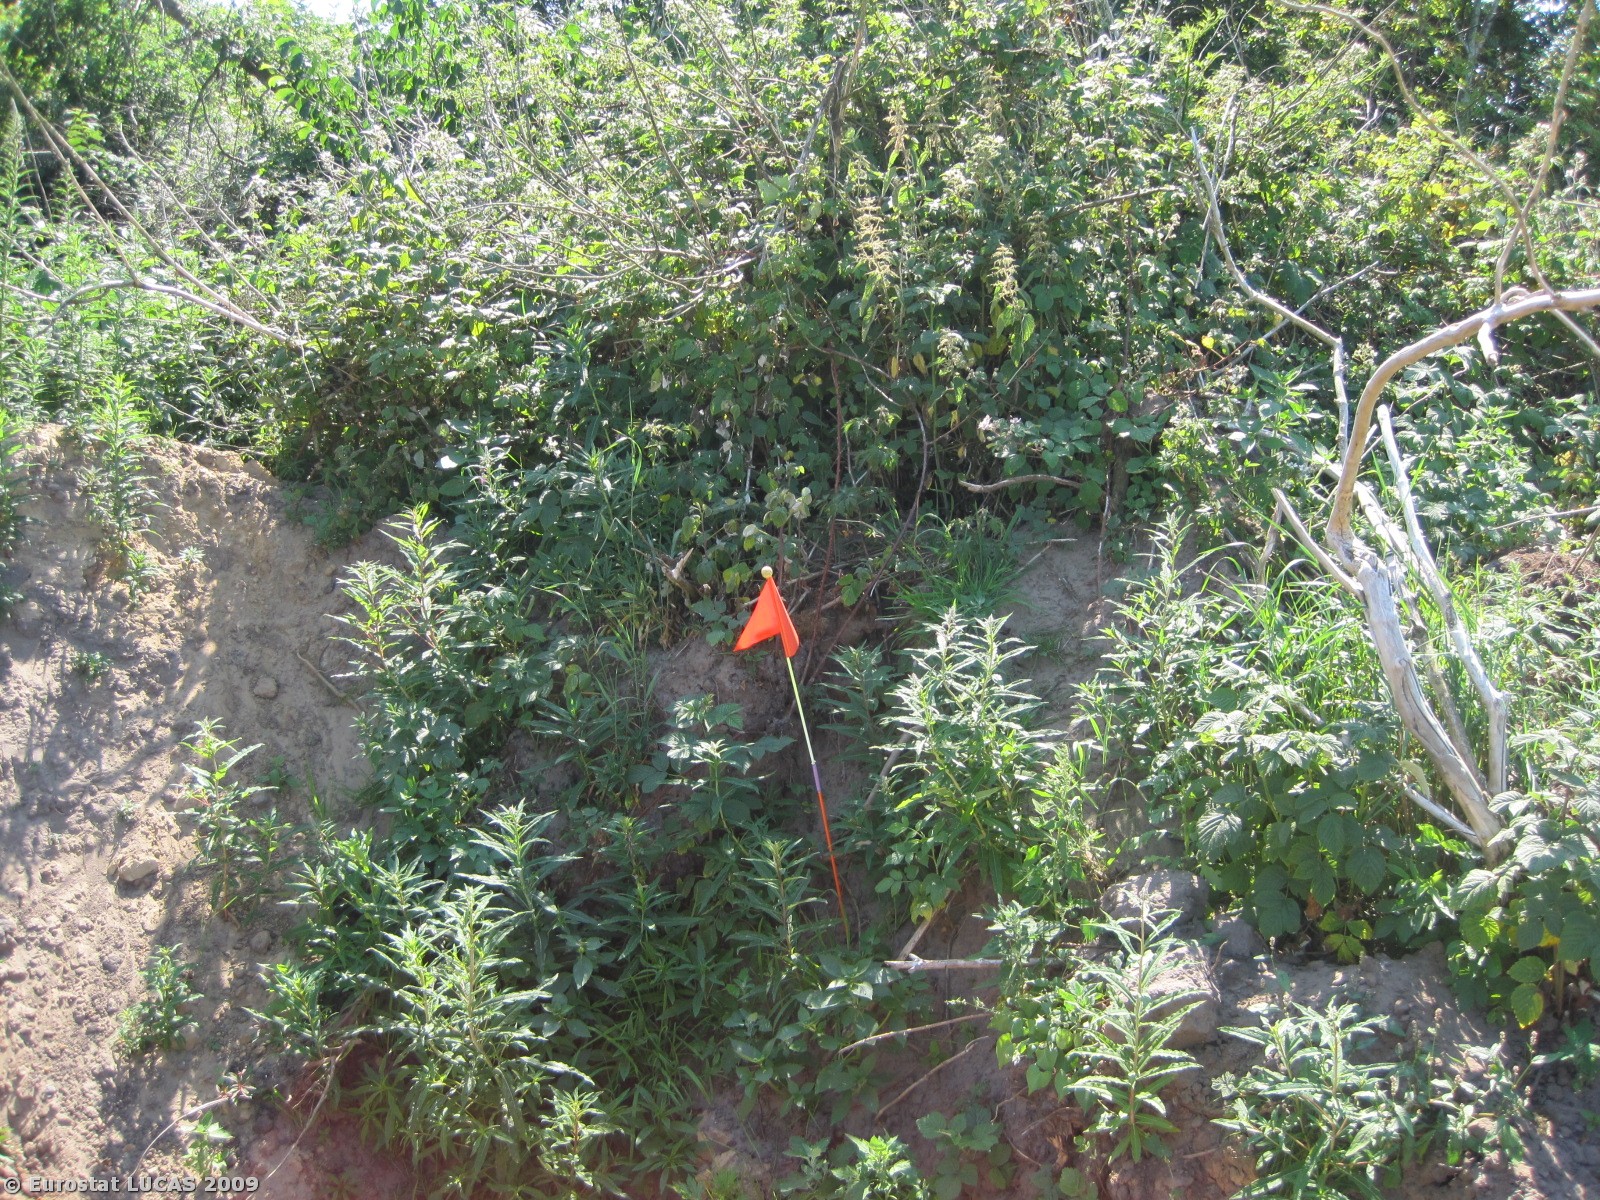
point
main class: Bare land
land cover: Bare land
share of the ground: > 75 %
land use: Unused
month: July
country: DK
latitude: 56.4107
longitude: 8.3326
